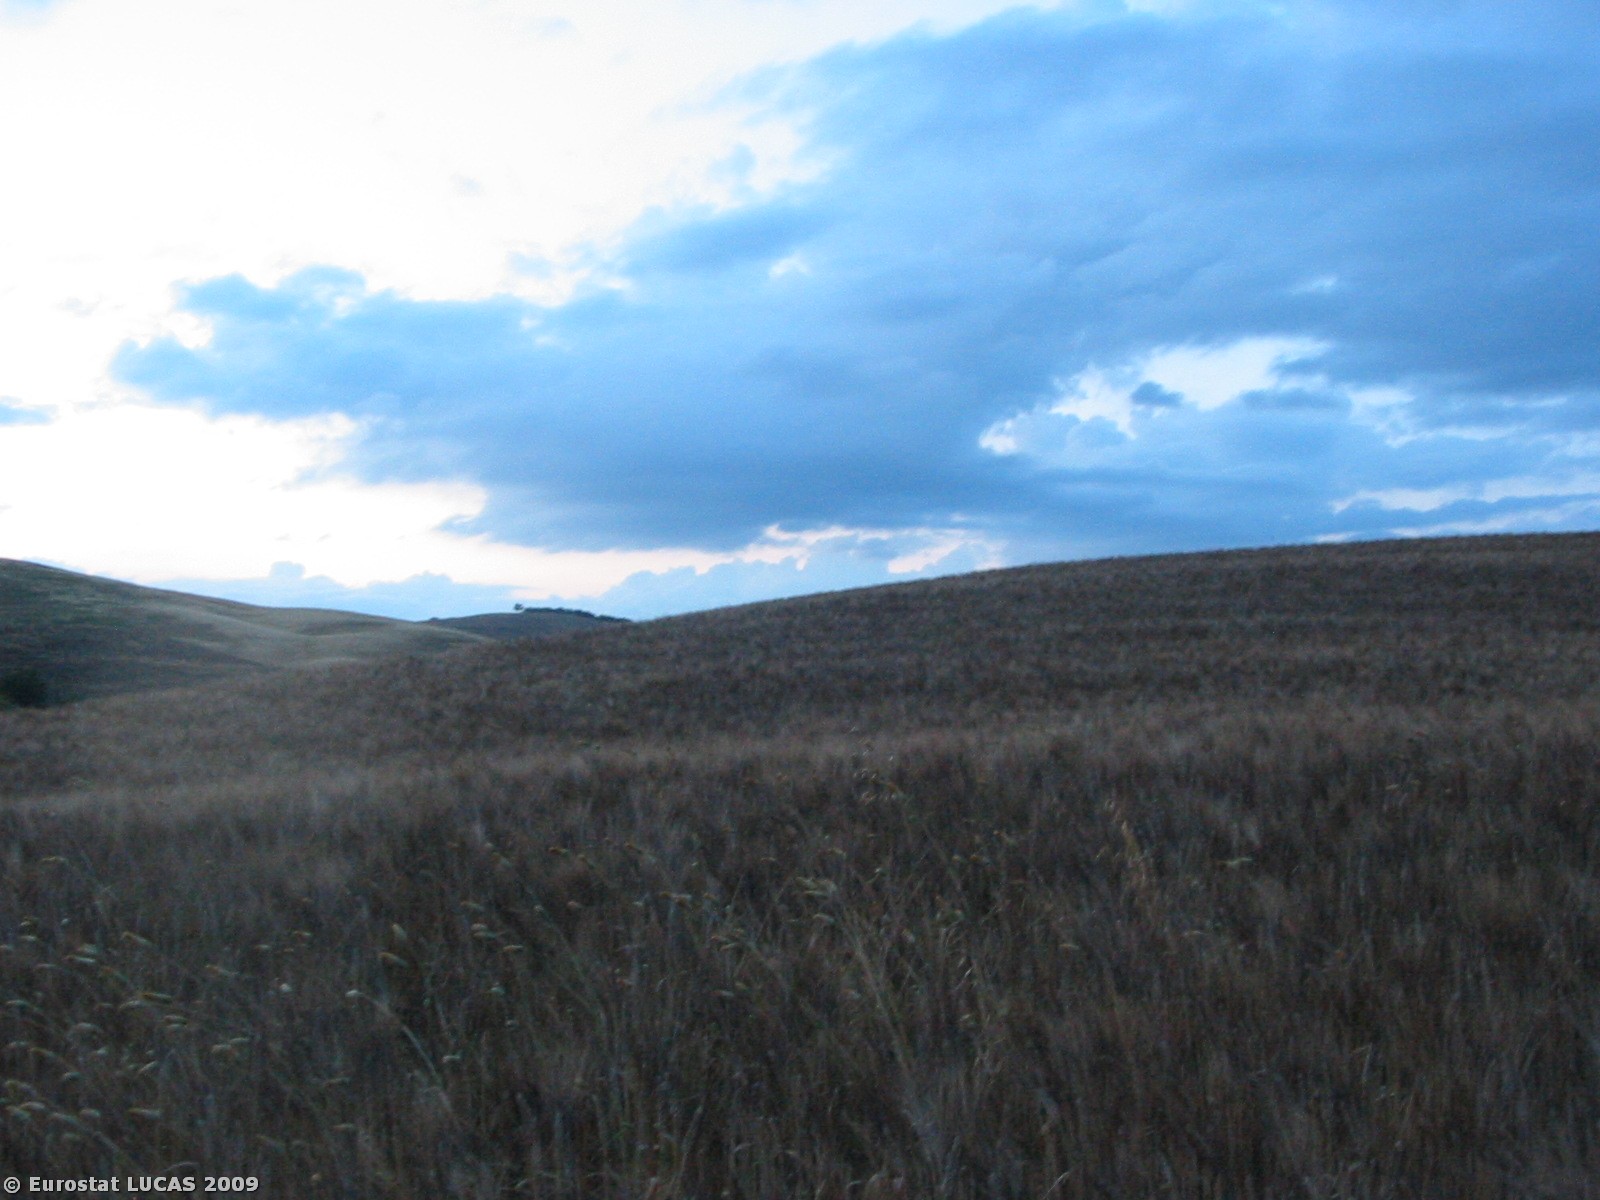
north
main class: Cropland
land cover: Durum wheat
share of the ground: > 75 %
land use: Agriculture (excluding fallow land and kitchen gardens)
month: June
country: IT
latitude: 43.0379
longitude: 11.6520
